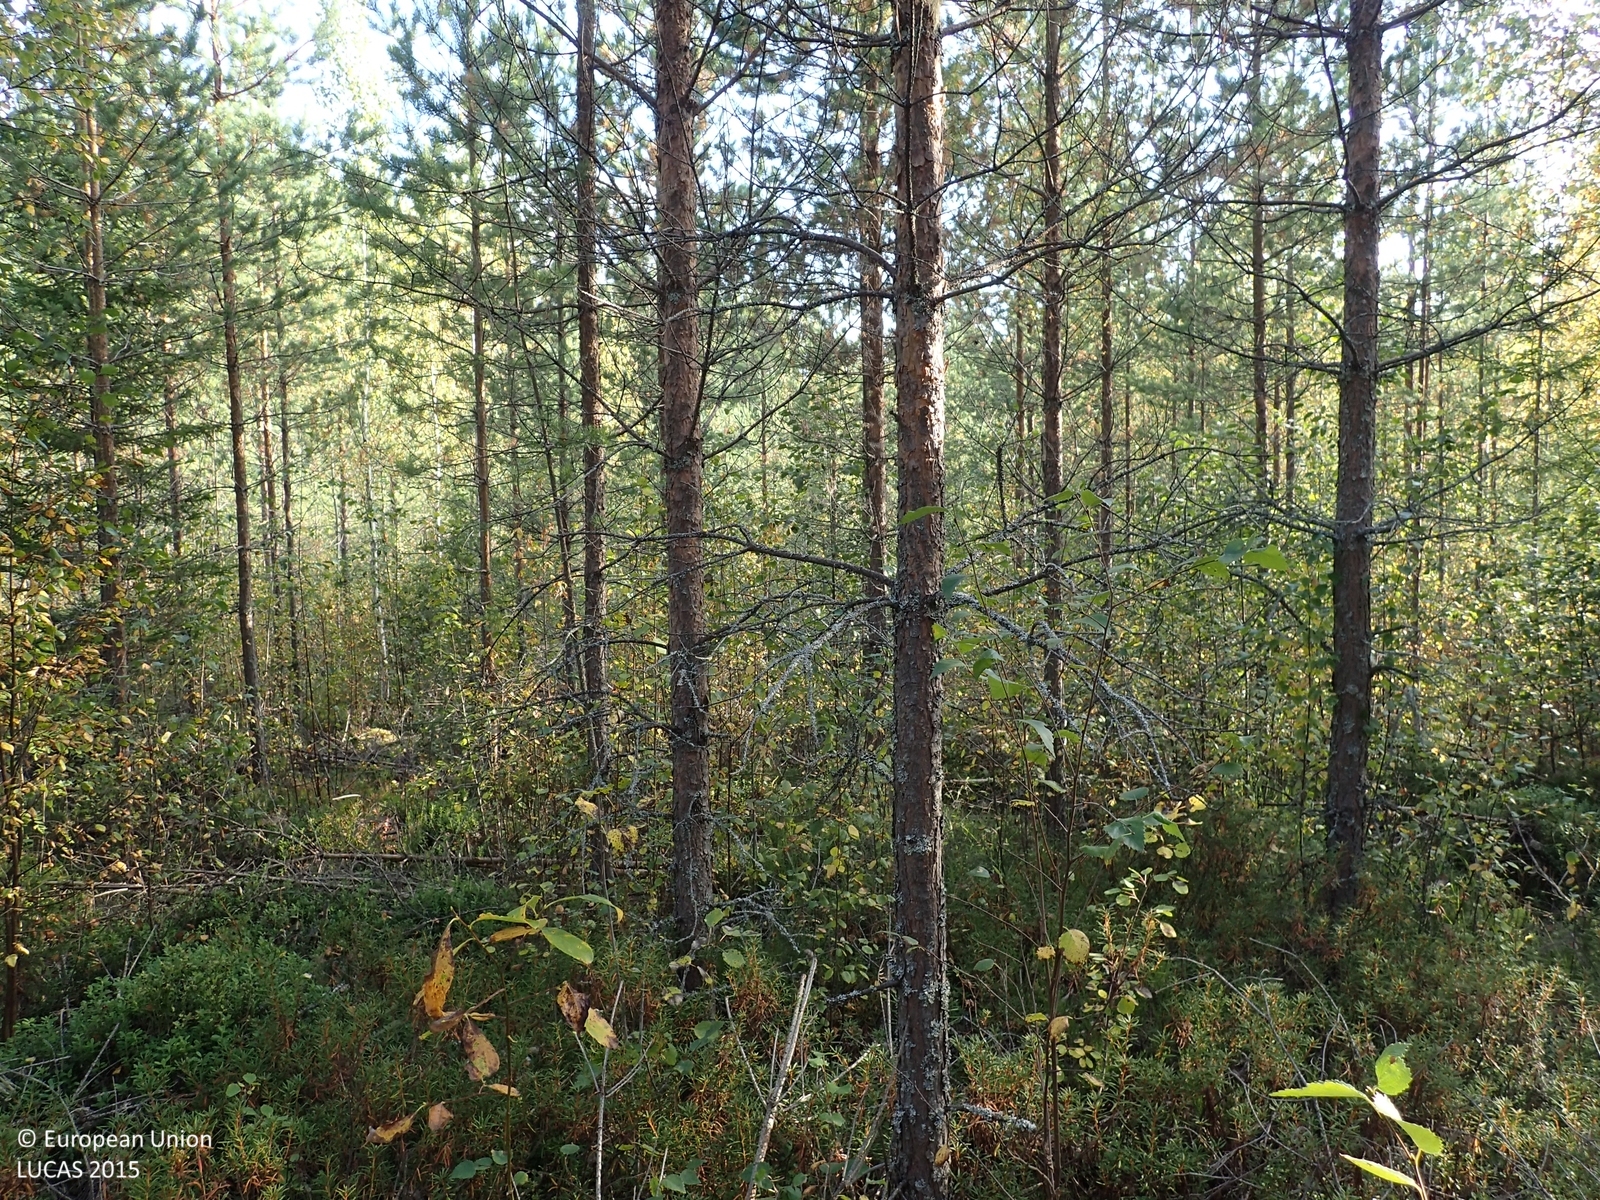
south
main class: Woodland
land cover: Pine dominated mixed woodland
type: boreal forest
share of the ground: > 75 %
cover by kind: coniferous forest trees 60 %, broadleaved forest trees 20 %, shrubs 20 %
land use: Forestry
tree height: < 5 m
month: September
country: FI
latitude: 63.0340
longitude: 25.5452
